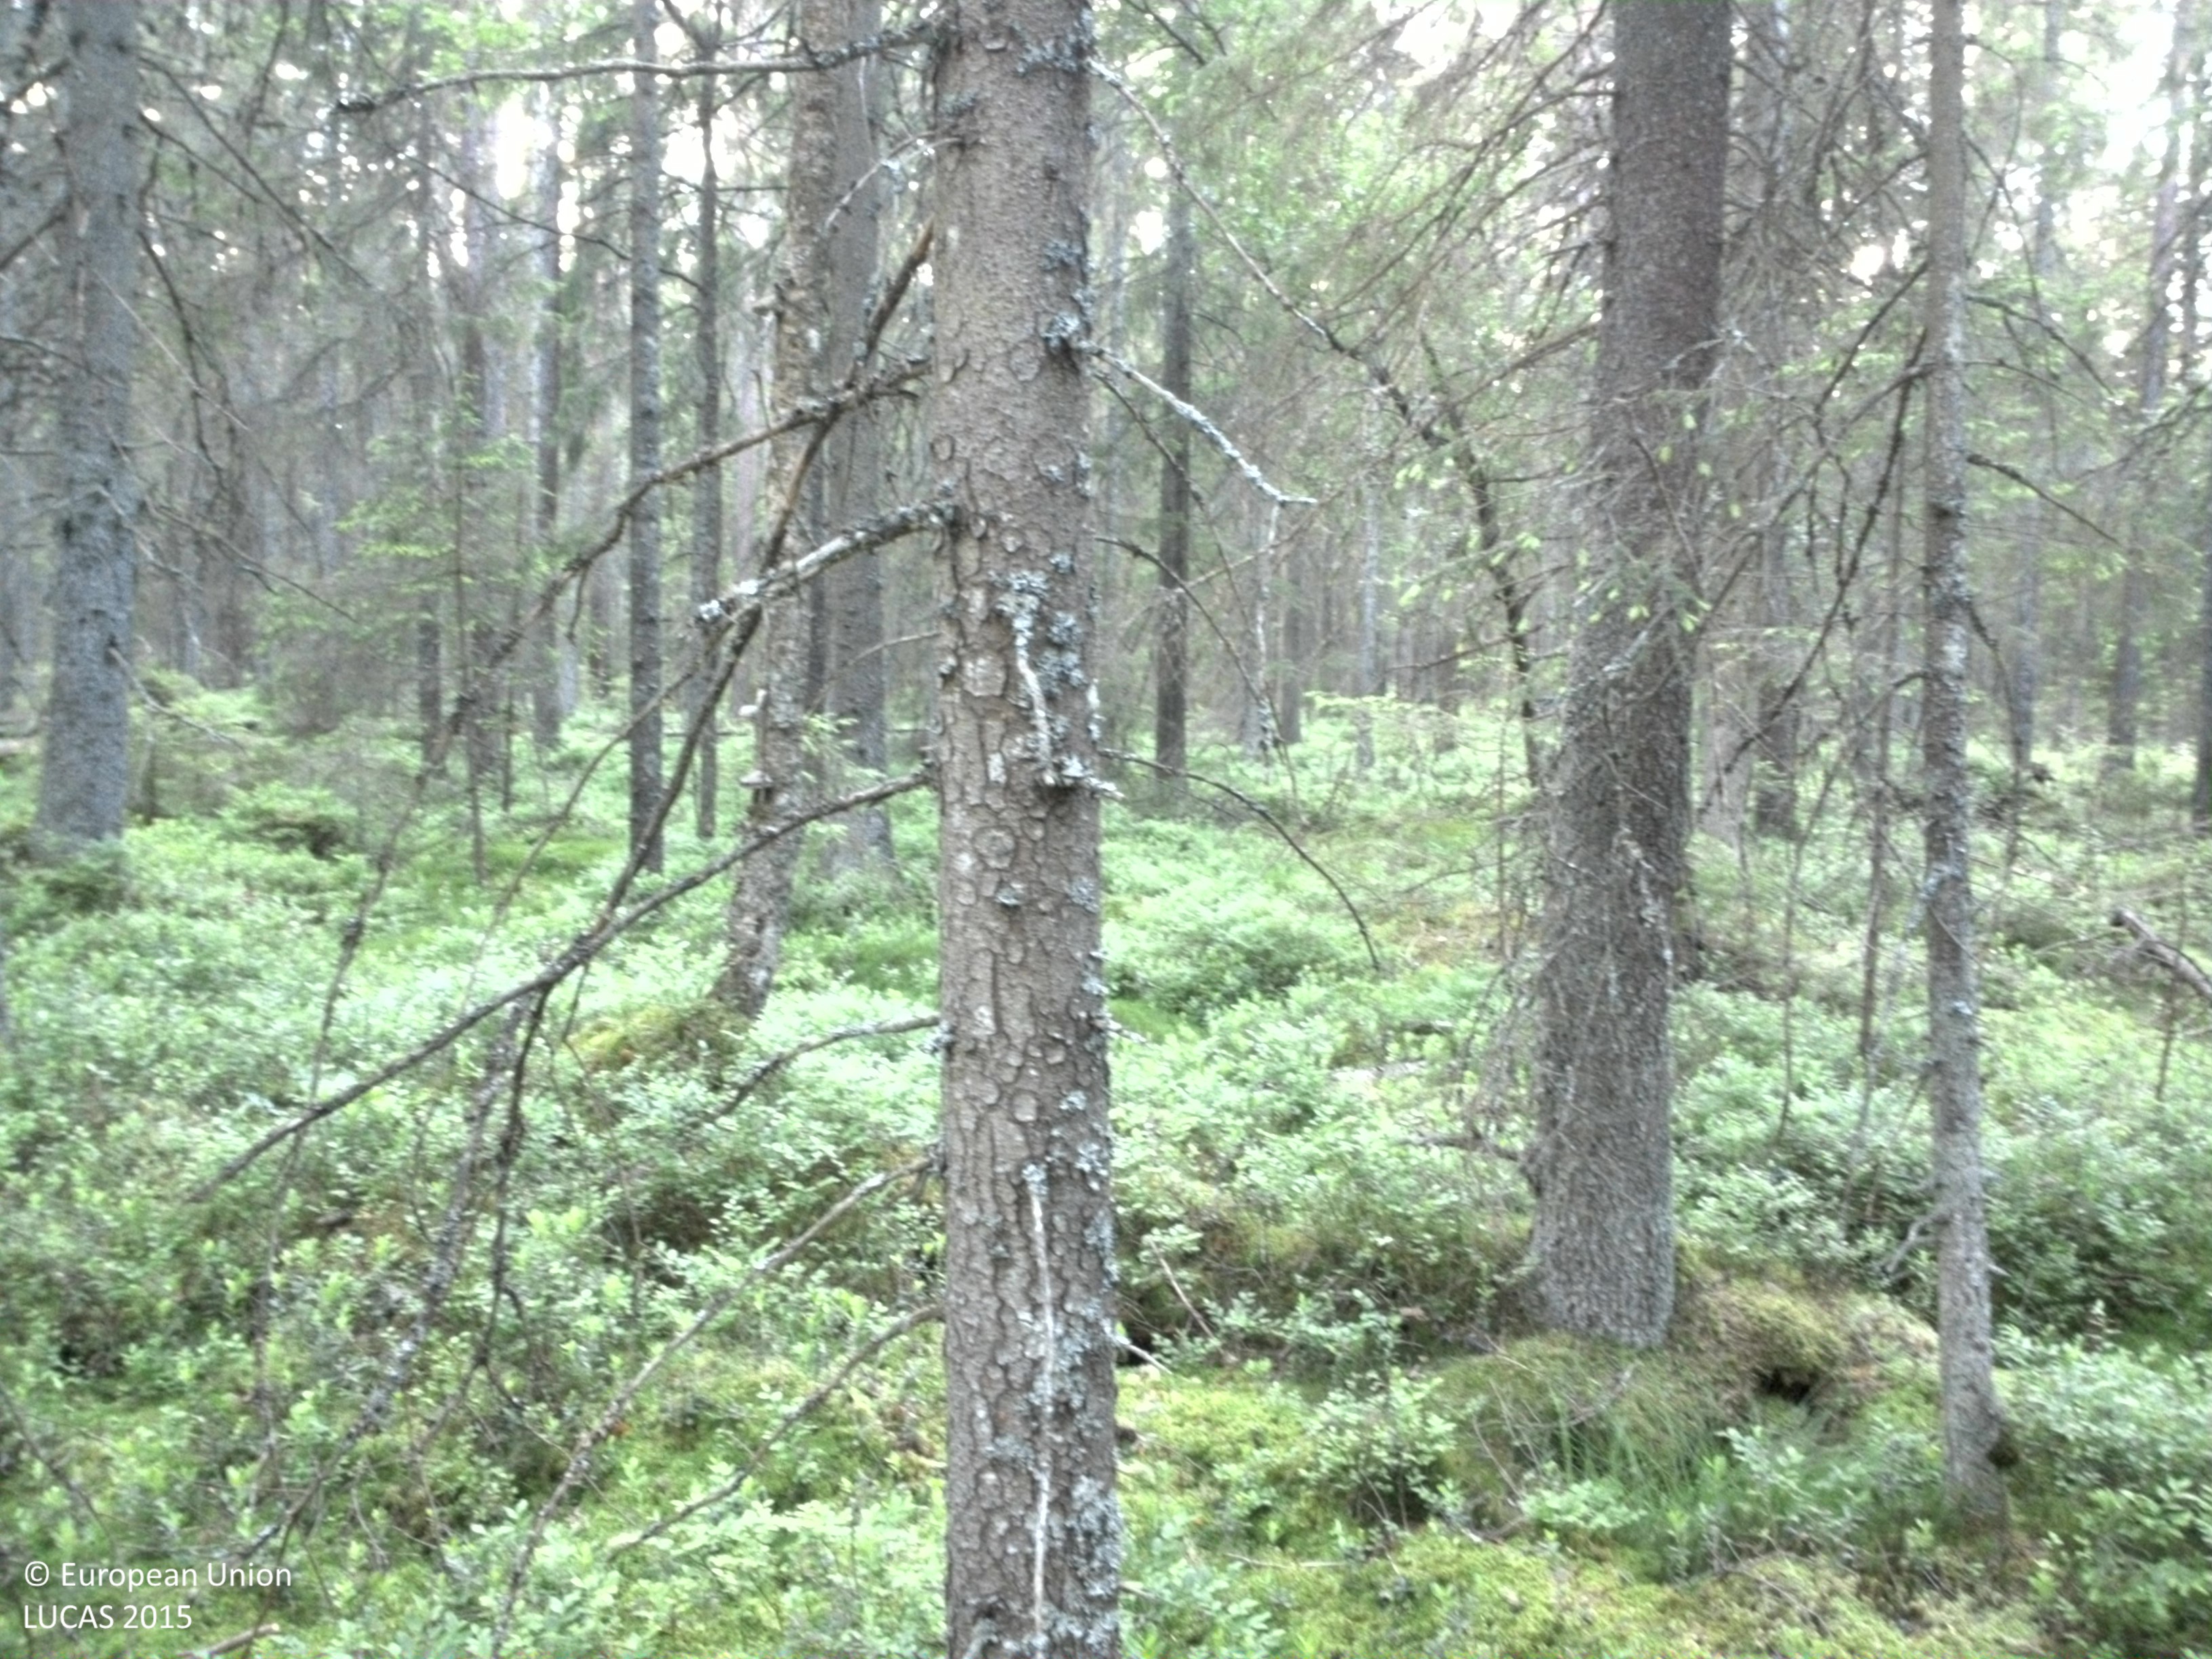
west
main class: Woodland
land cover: Spruce dominated coniferous woodland
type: boreal forest
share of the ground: 50 - 75 %
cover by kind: coniferous forest trees 75 %, lichens and mosses 15 %, shrubs 10 %
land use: Forestry
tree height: > 5 m
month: June
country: SE
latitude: 57.7116
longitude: 13.9395
